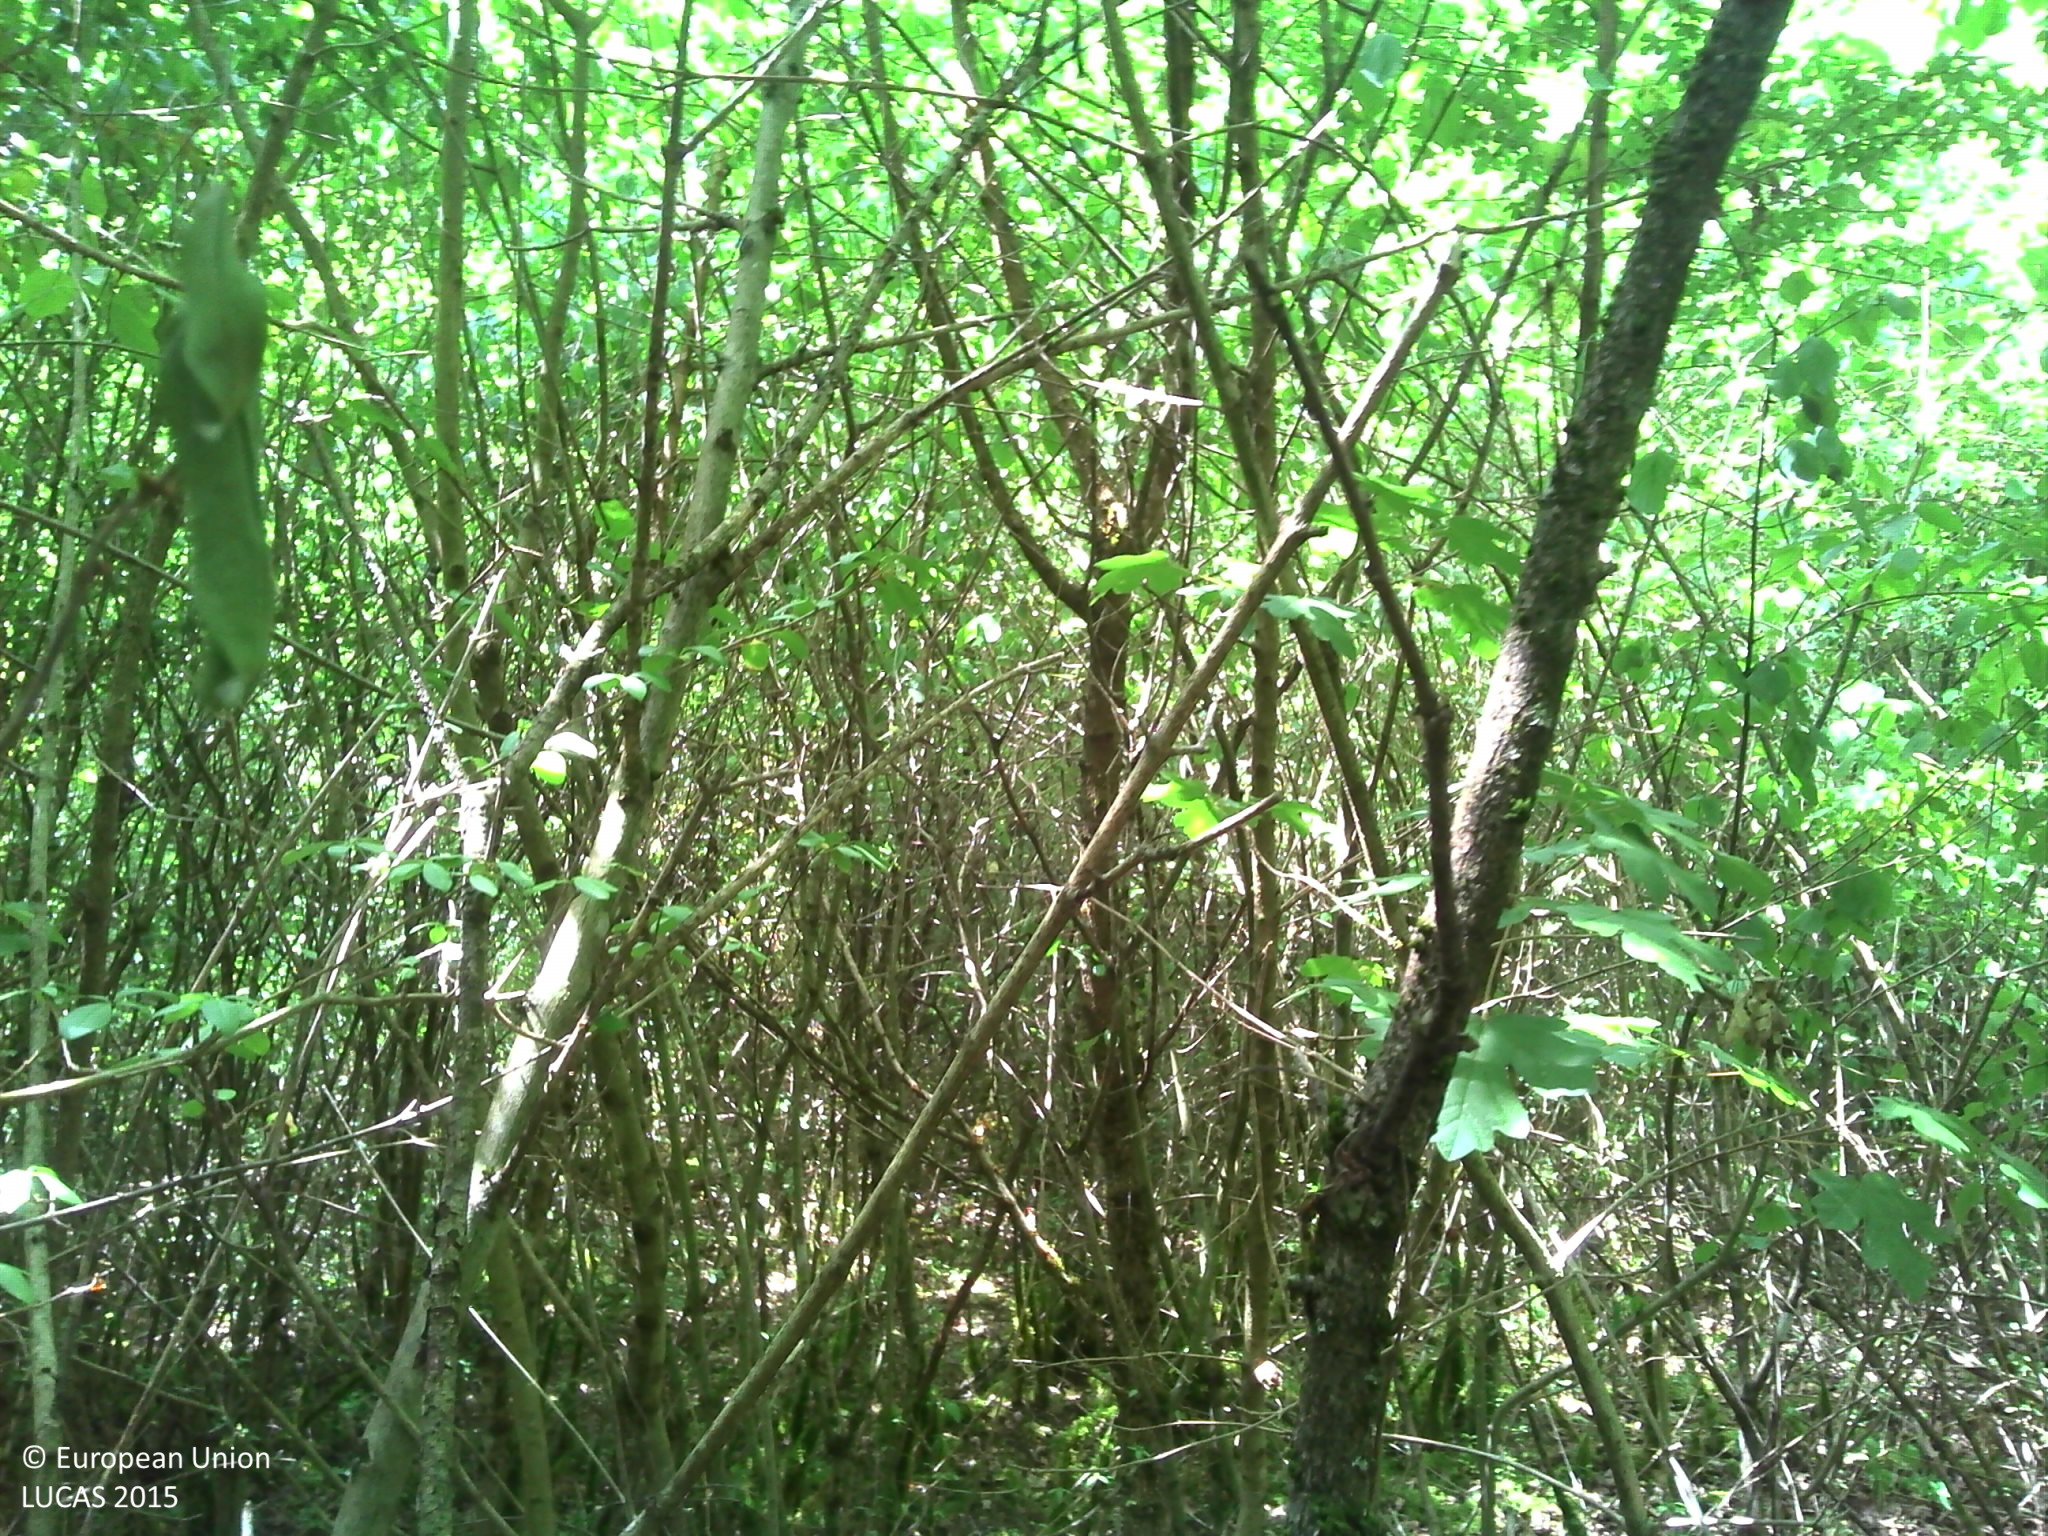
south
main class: Woodland
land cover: Broadleaved woodland
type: mesophytic deciduous forest
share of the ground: > 75 %
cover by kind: broadleaved forest trees 85 %, lichens and mosses 10 %, herbaceous plants 5 %
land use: Forestry
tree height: > 5 m
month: July
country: FR
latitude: 45.6578
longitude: 5.4227
